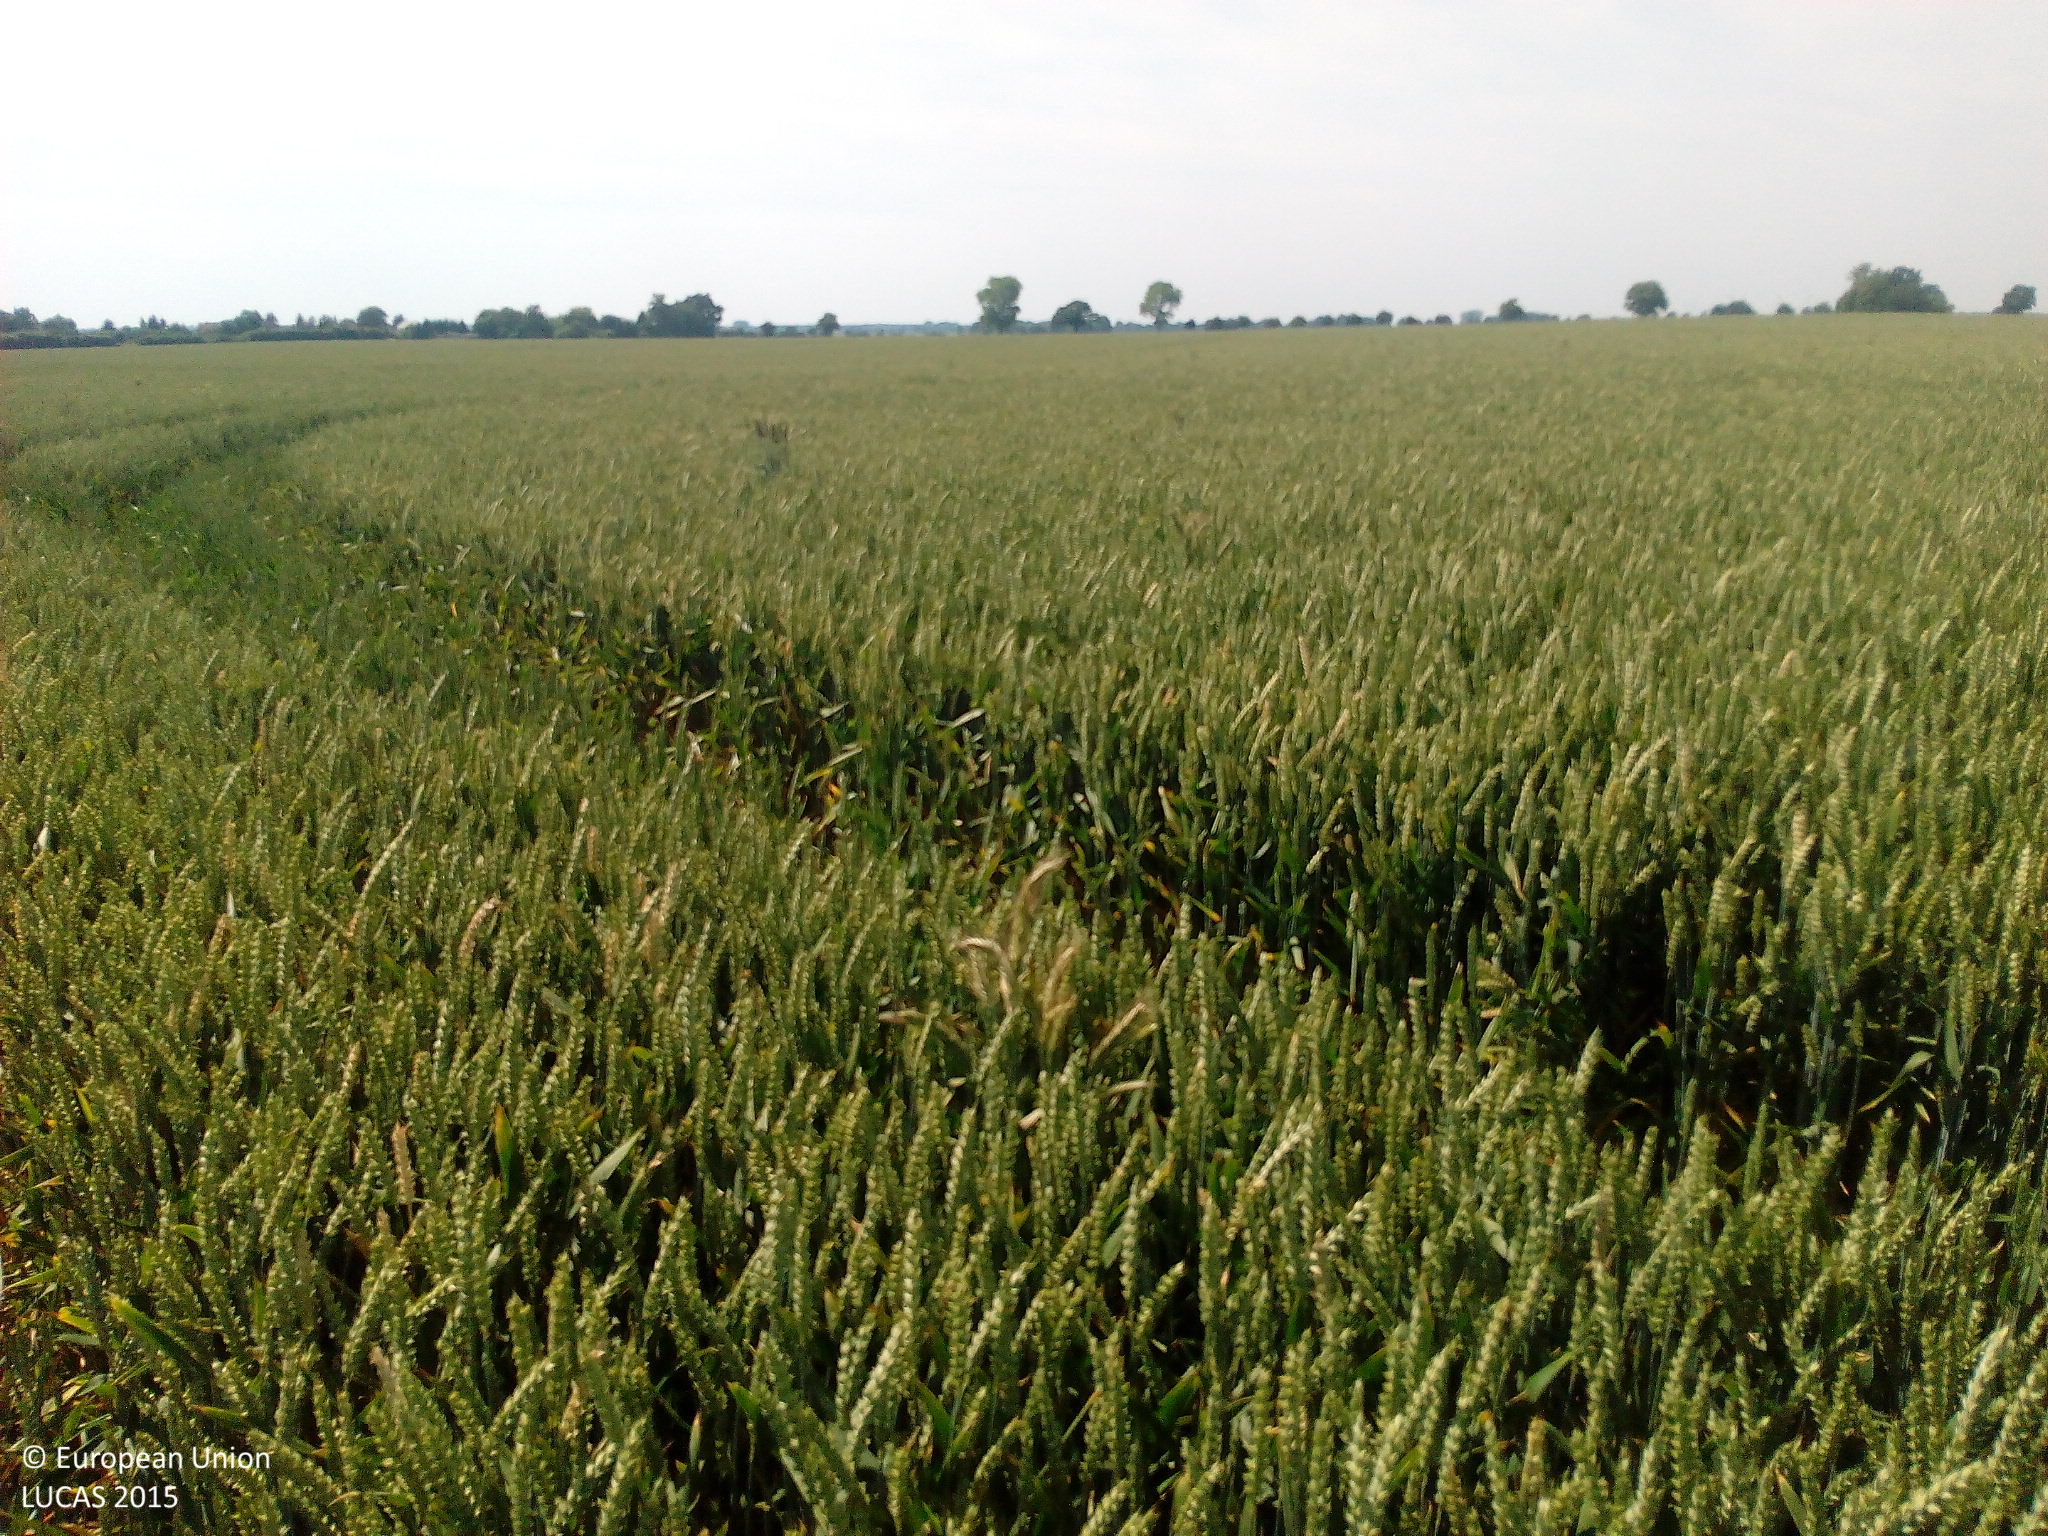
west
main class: Cropland
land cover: Common wheat
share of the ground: > 75 %
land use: Agriculture (excluding fallow land and kitchen gardens)
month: July
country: DE
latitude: 53.8795
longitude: 13.2699
